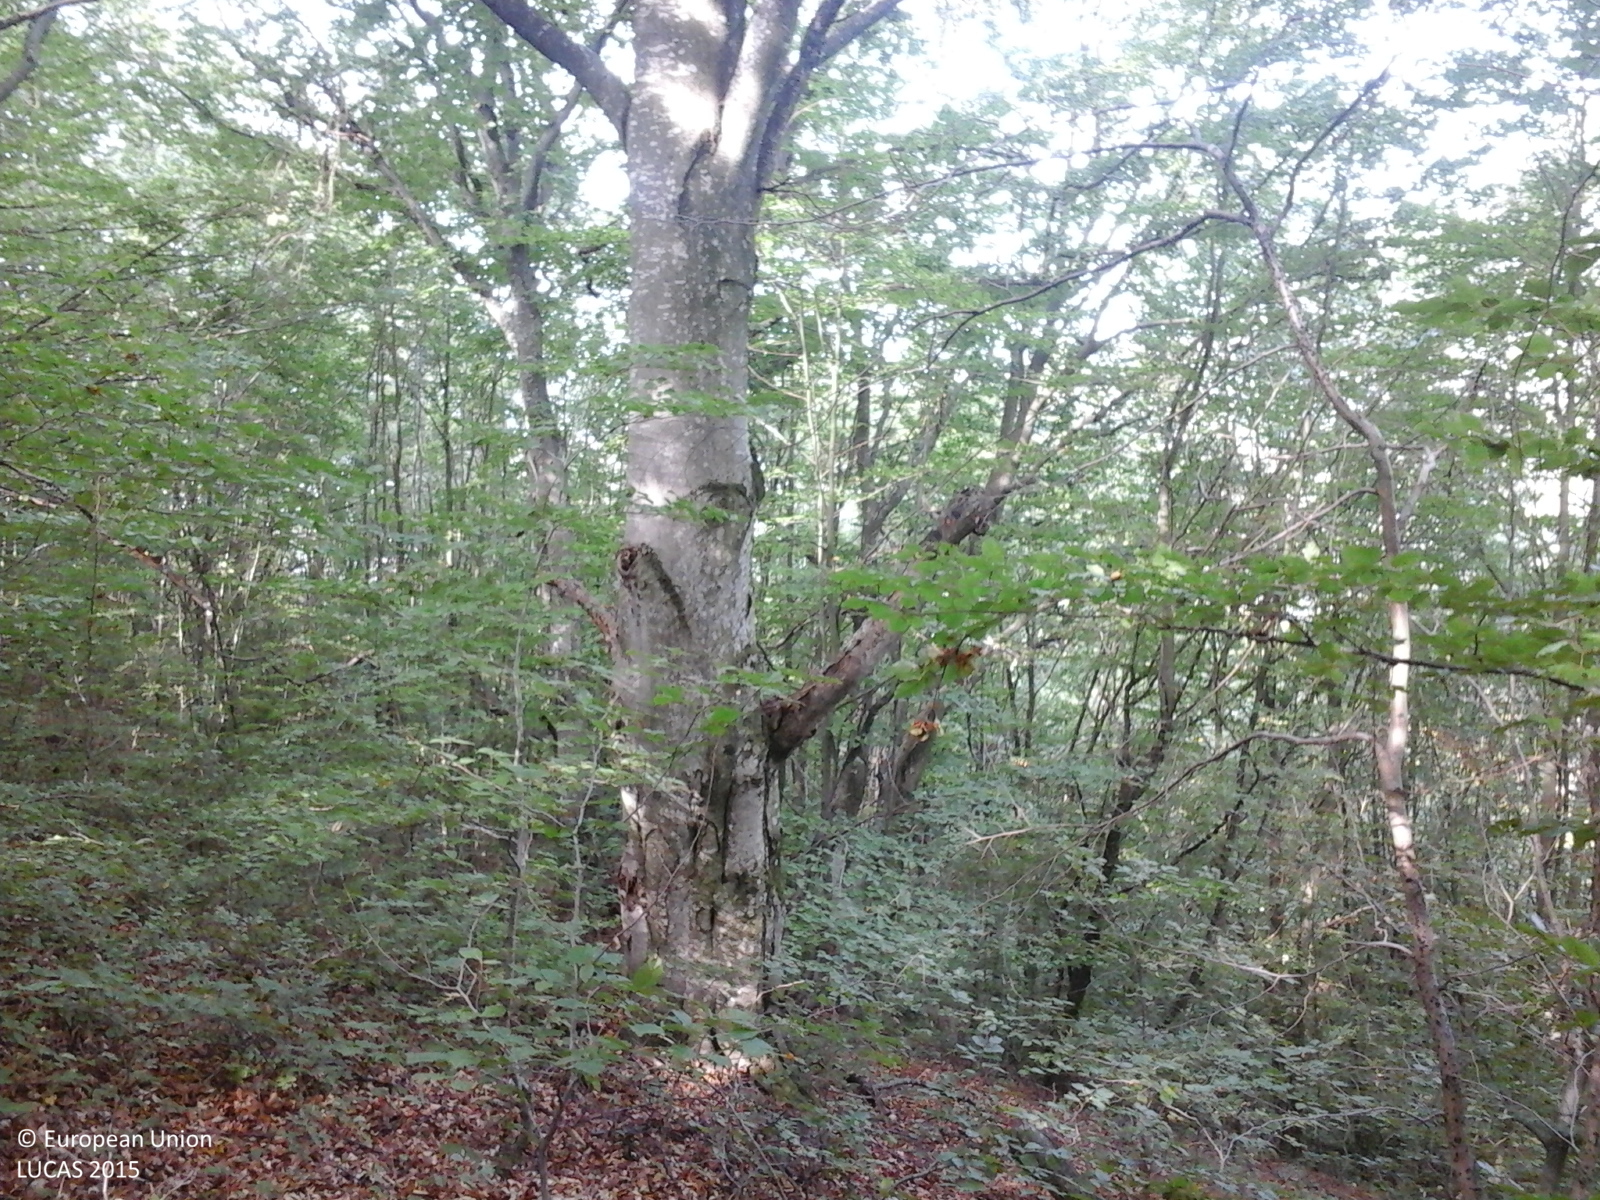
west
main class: Woodland
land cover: Broadleaved woodland
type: mesophytic deciduous forest
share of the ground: > 75 %
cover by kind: broadleaved forest trees 100 %
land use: Forestry
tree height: > 5 m
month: September
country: RO
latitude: 47.2118
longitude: 23.7420
